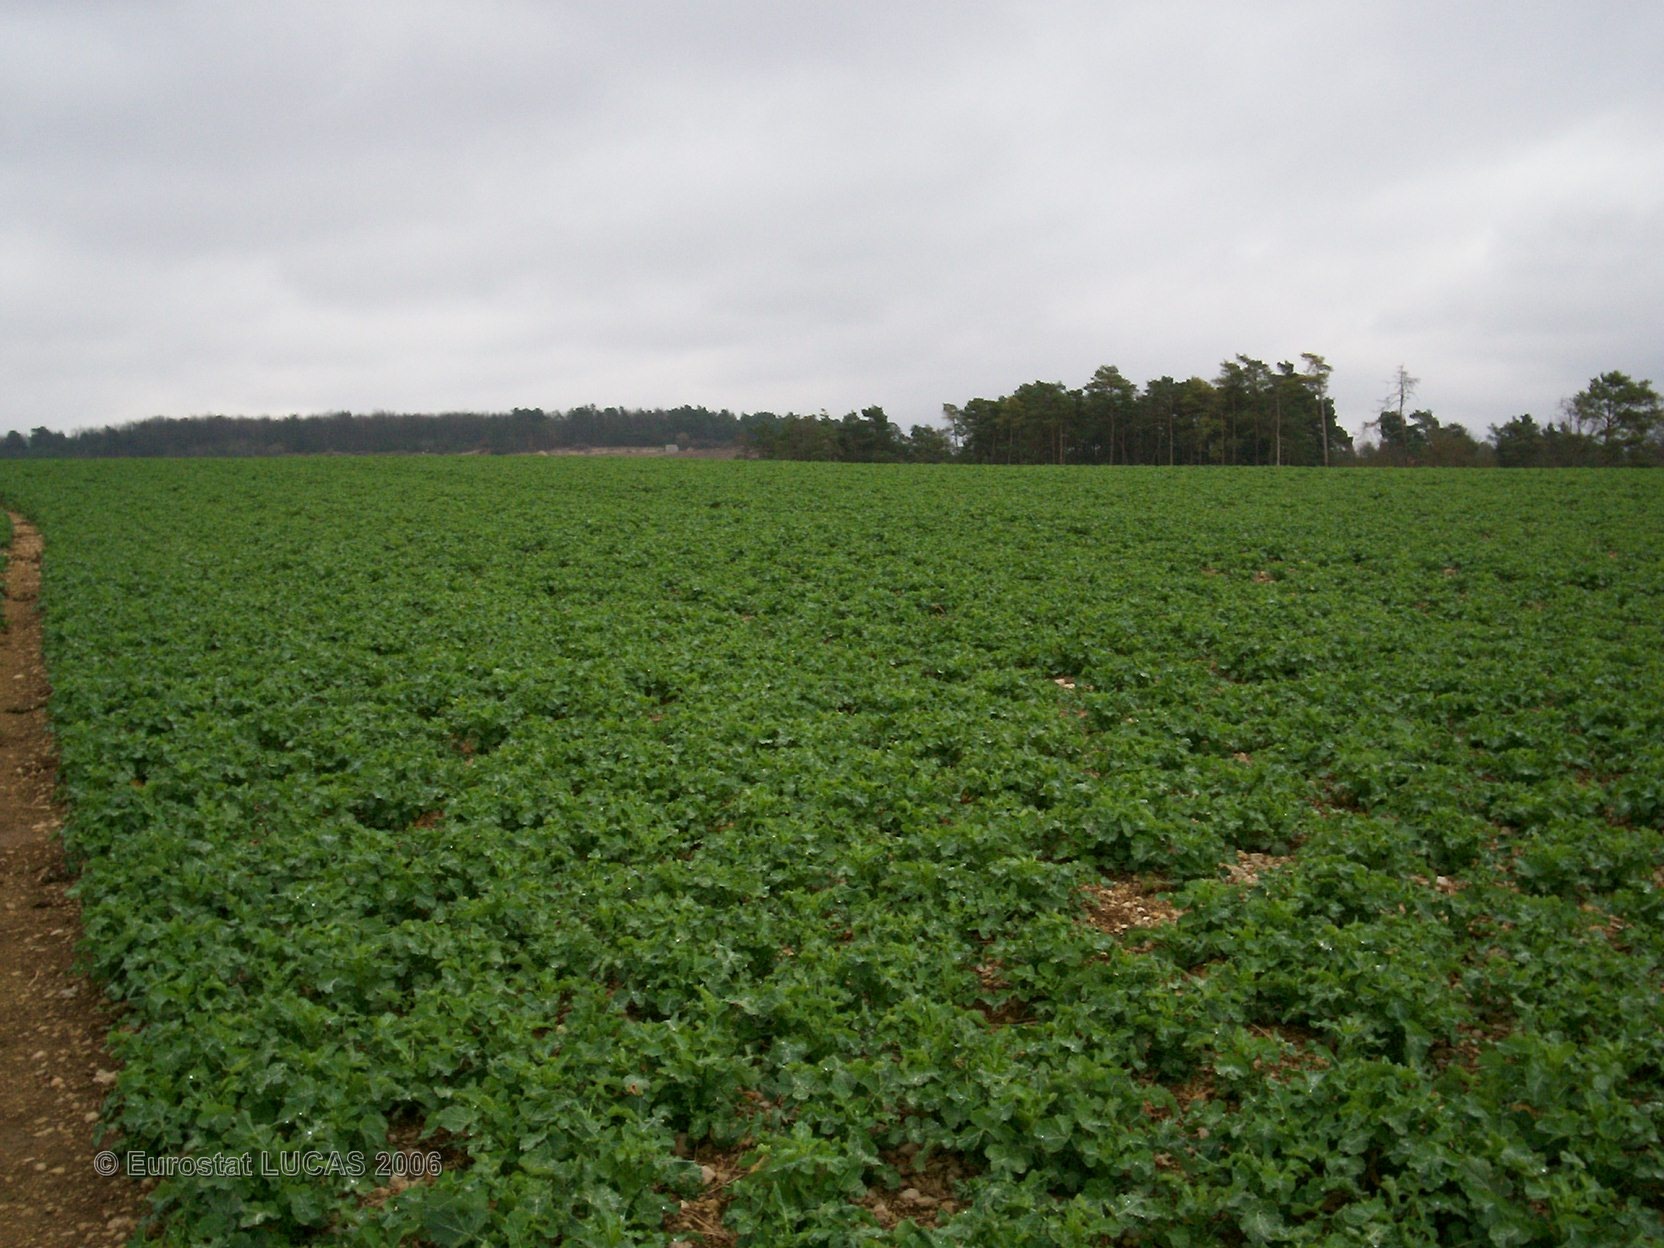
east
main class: Cropland
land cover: Rape and turnip rape
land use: Agriculture (excluding fallow land and kitchen gardens)
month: April
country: FR
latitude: 48.0687
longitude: 4.5090
